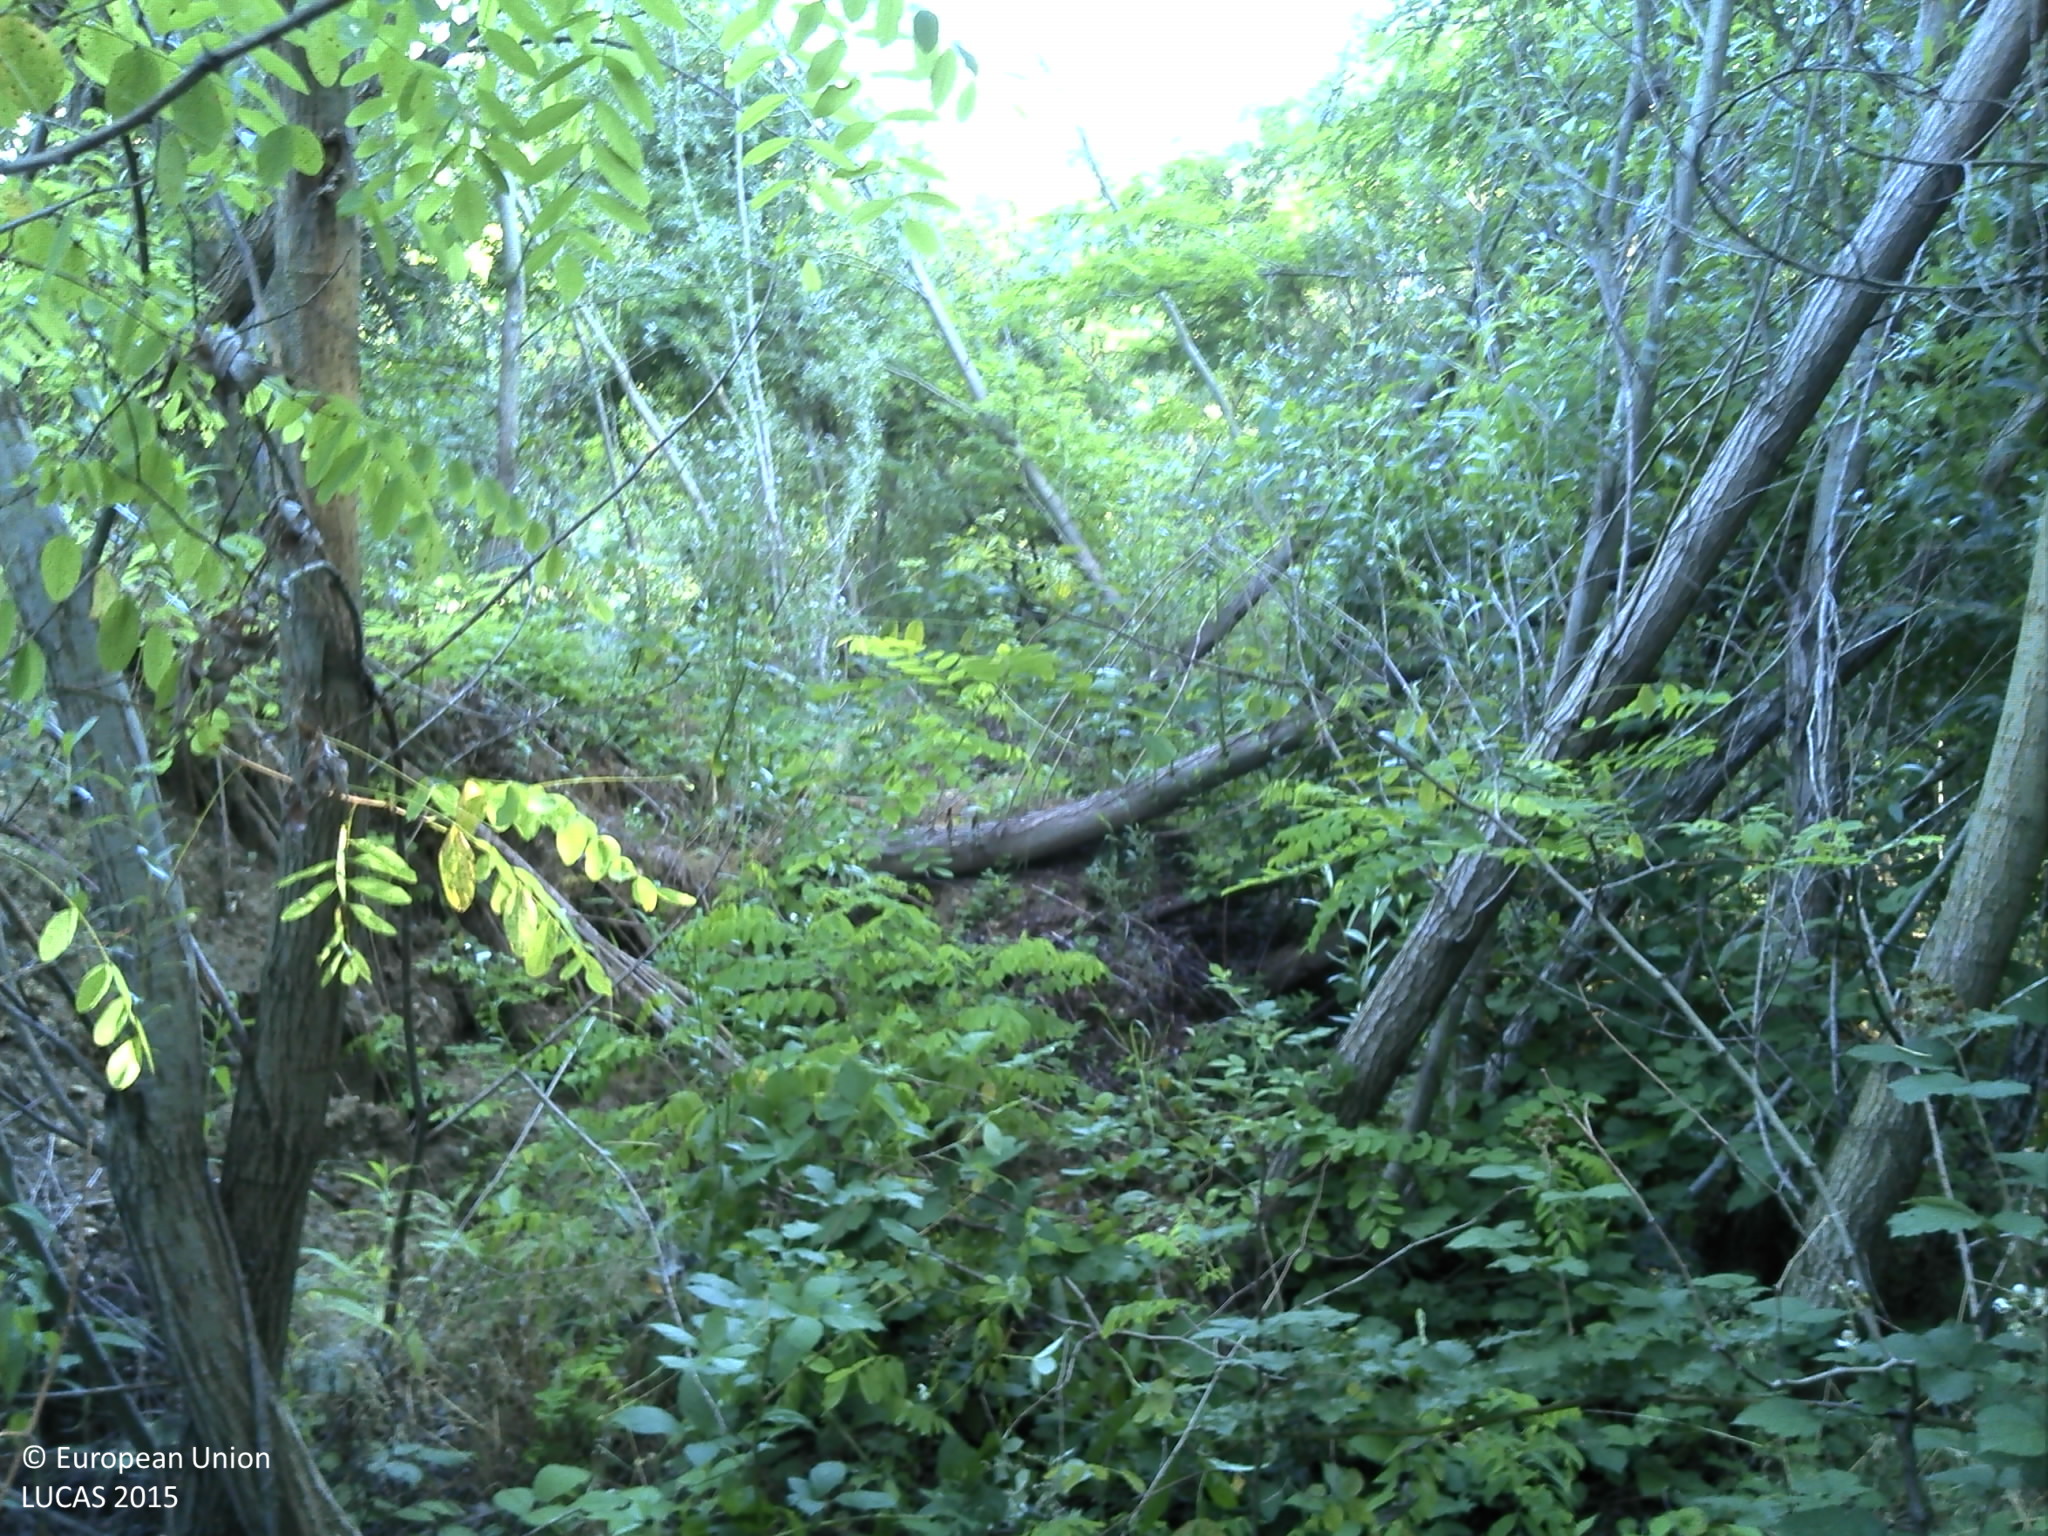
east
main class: Woodland
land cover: Broadleaved woodland
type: acidophilous oak and oak-birch forest
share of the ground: > 75 %
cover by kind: broadleaved forest trees 90 %, shrubs 10 %
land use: Forestry
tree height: < 5 m
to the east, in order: Broadleaved woodland
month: June
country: HR
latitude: 45.8303
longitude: 17.3010
